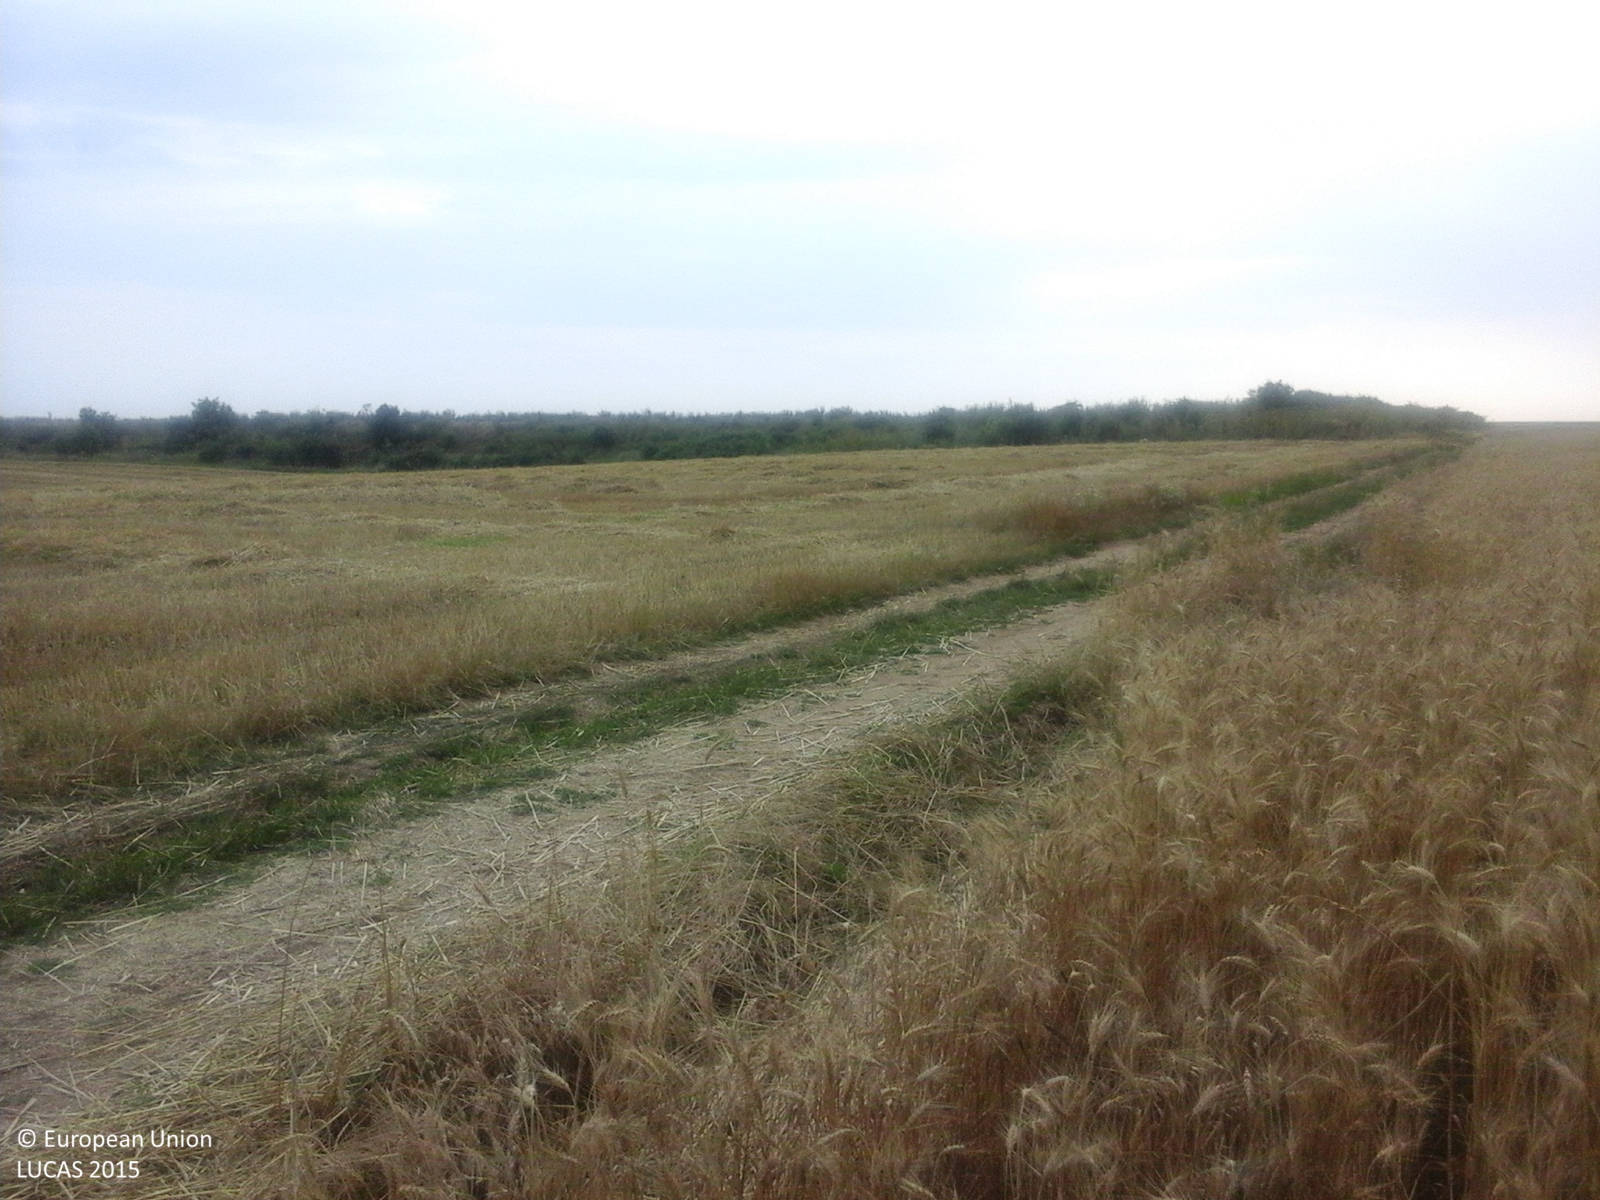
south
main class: Cropland
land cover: Common wheat
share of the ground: > 75 %
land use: Agriculture (excluding fallow land and kitchen gardens)
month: June
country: RO
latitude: 44.2704
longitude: 26.0246
